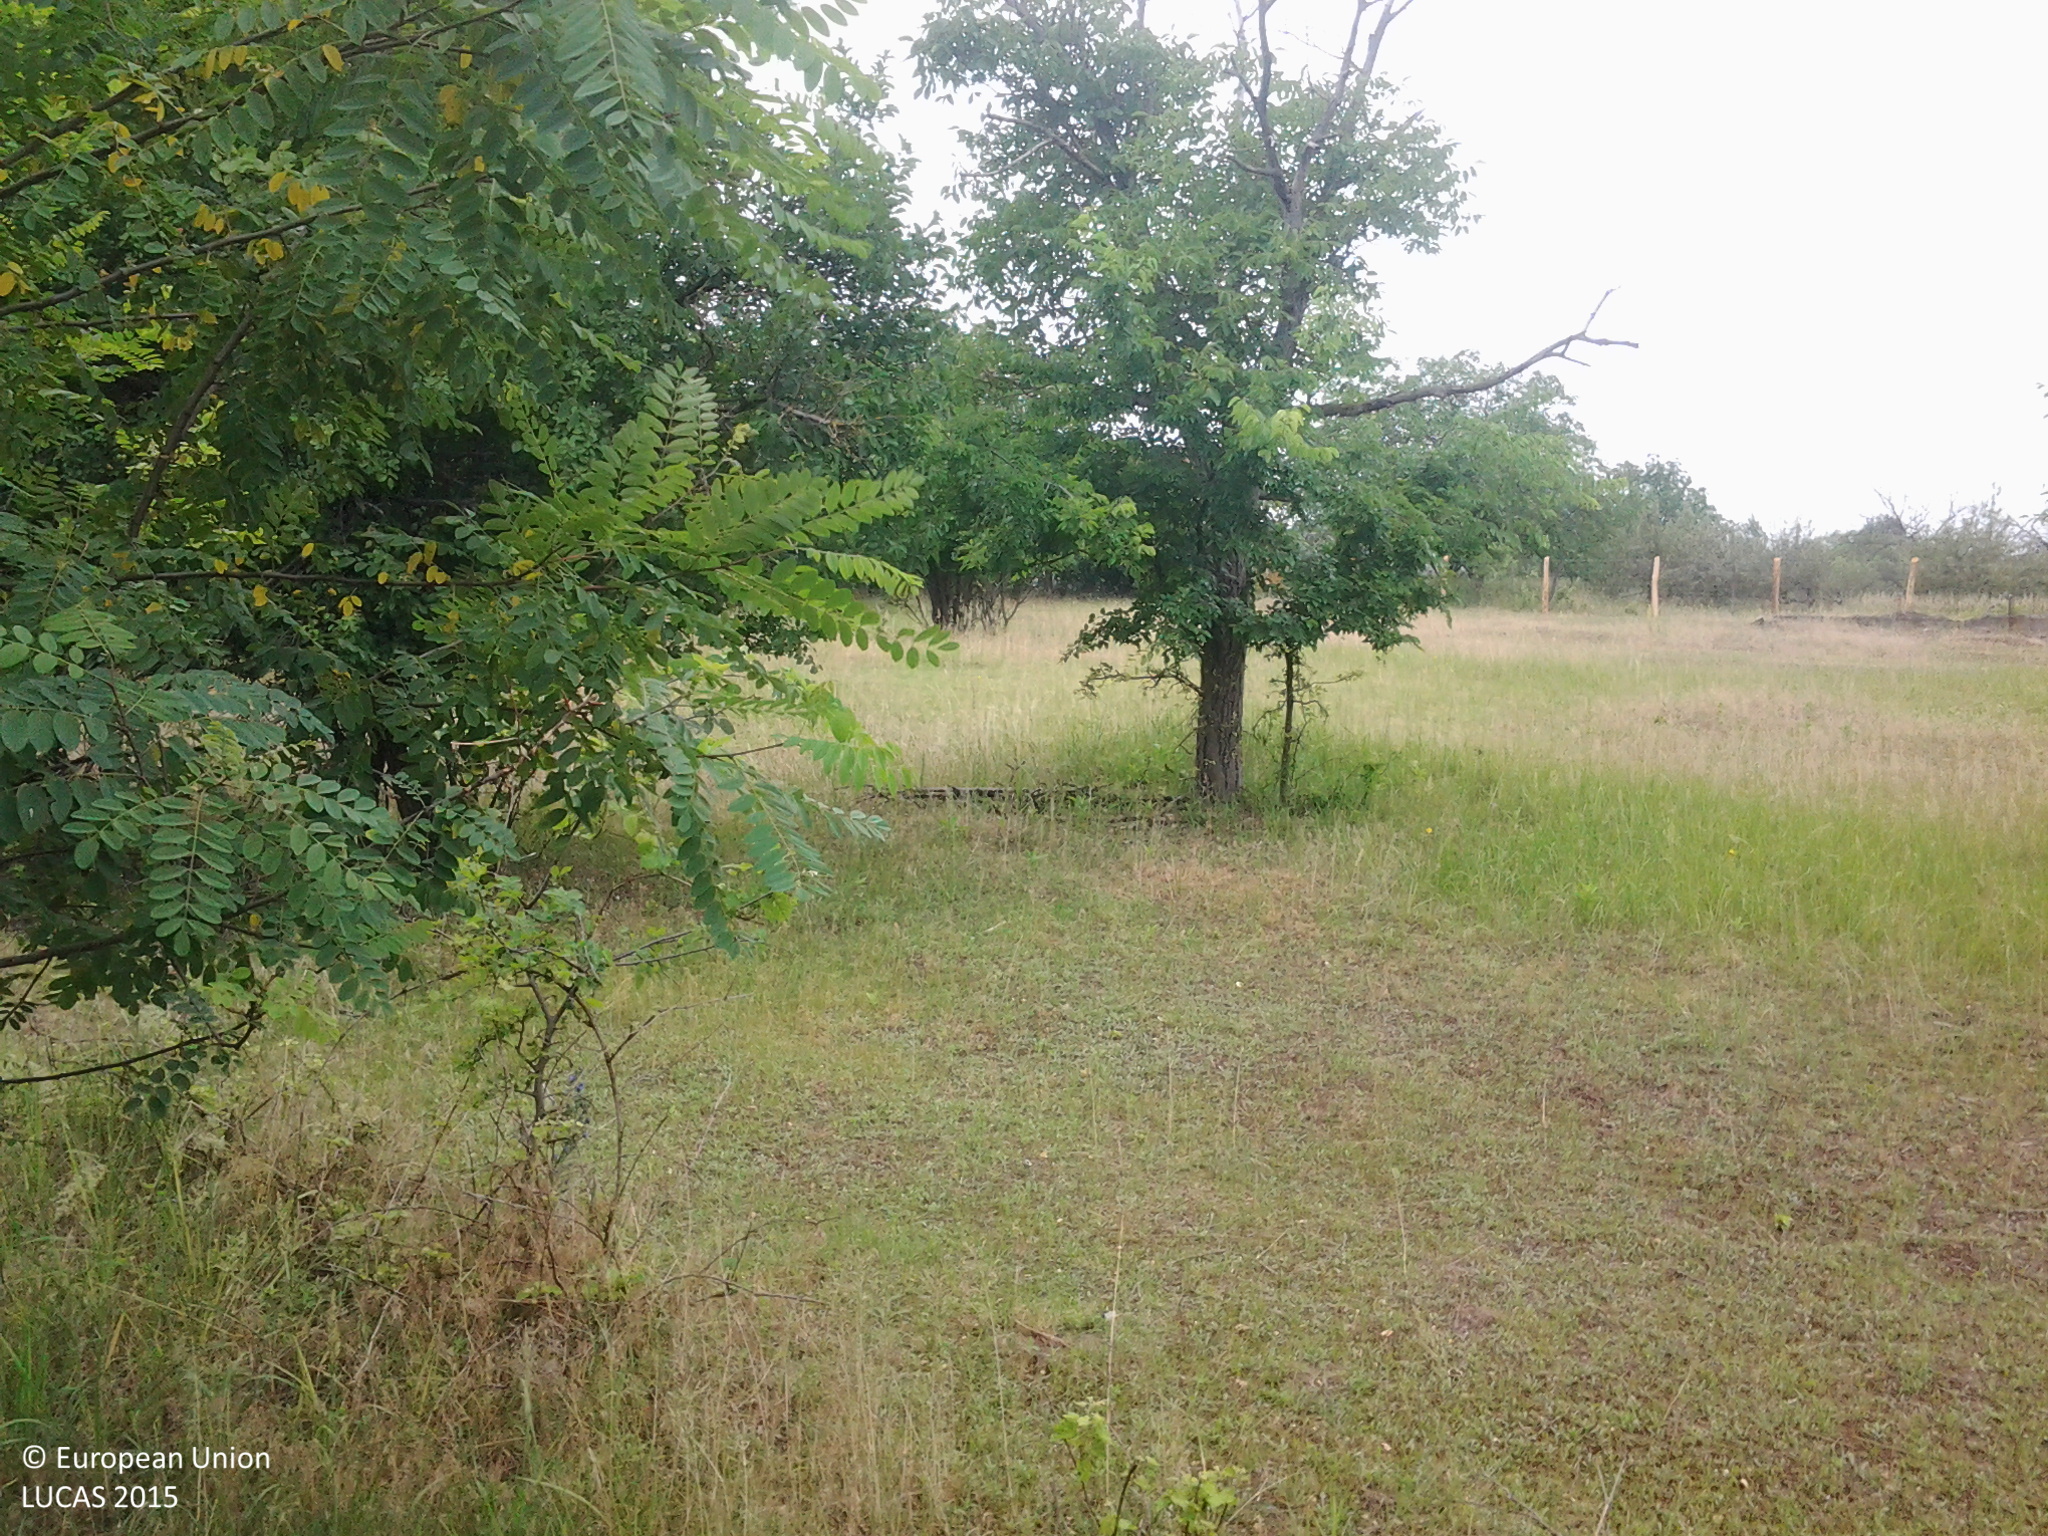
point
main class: Woodland
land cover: Broadleaved woodland
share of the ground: 10 - 25 %
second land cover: Grassland without tree/shrub cover
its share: > 75 %
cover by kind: herbaceous plants 80 %, broadleaved forest trees 20 %
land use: Forestry
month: June
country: HU
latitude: 46.9272
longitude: 19.6737
